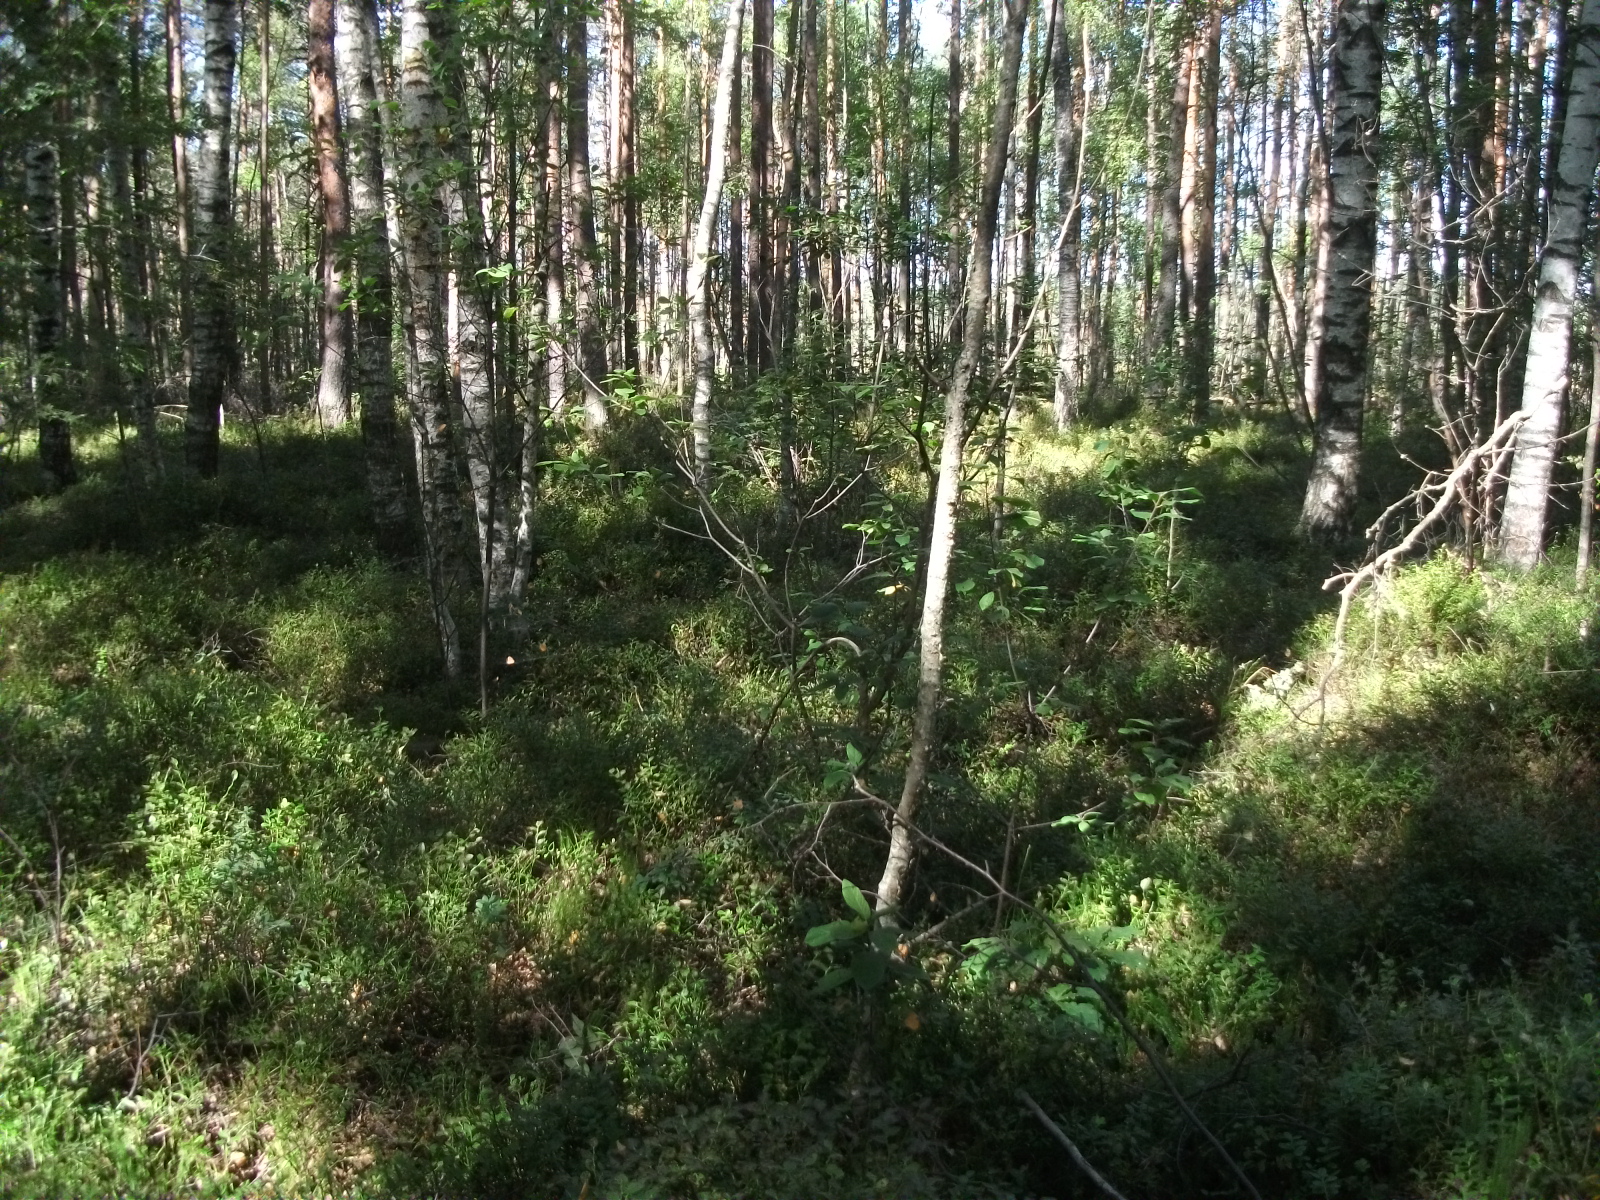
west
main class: Woodland
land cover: Pine dominated mixed woodland
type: hemiboreal forest and nemoral coniferous forest and mixed broadleaved-coniferous forest
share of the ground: > 75 %
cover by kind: broadleaved forest trees 55 %, coniferous forest trees 30 %, herbaceous plants 10 %, lichens and mosses 5 %
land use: Forestry
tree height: > 5 m
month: August
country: LV
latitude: 56.6779
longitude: 26.3166
